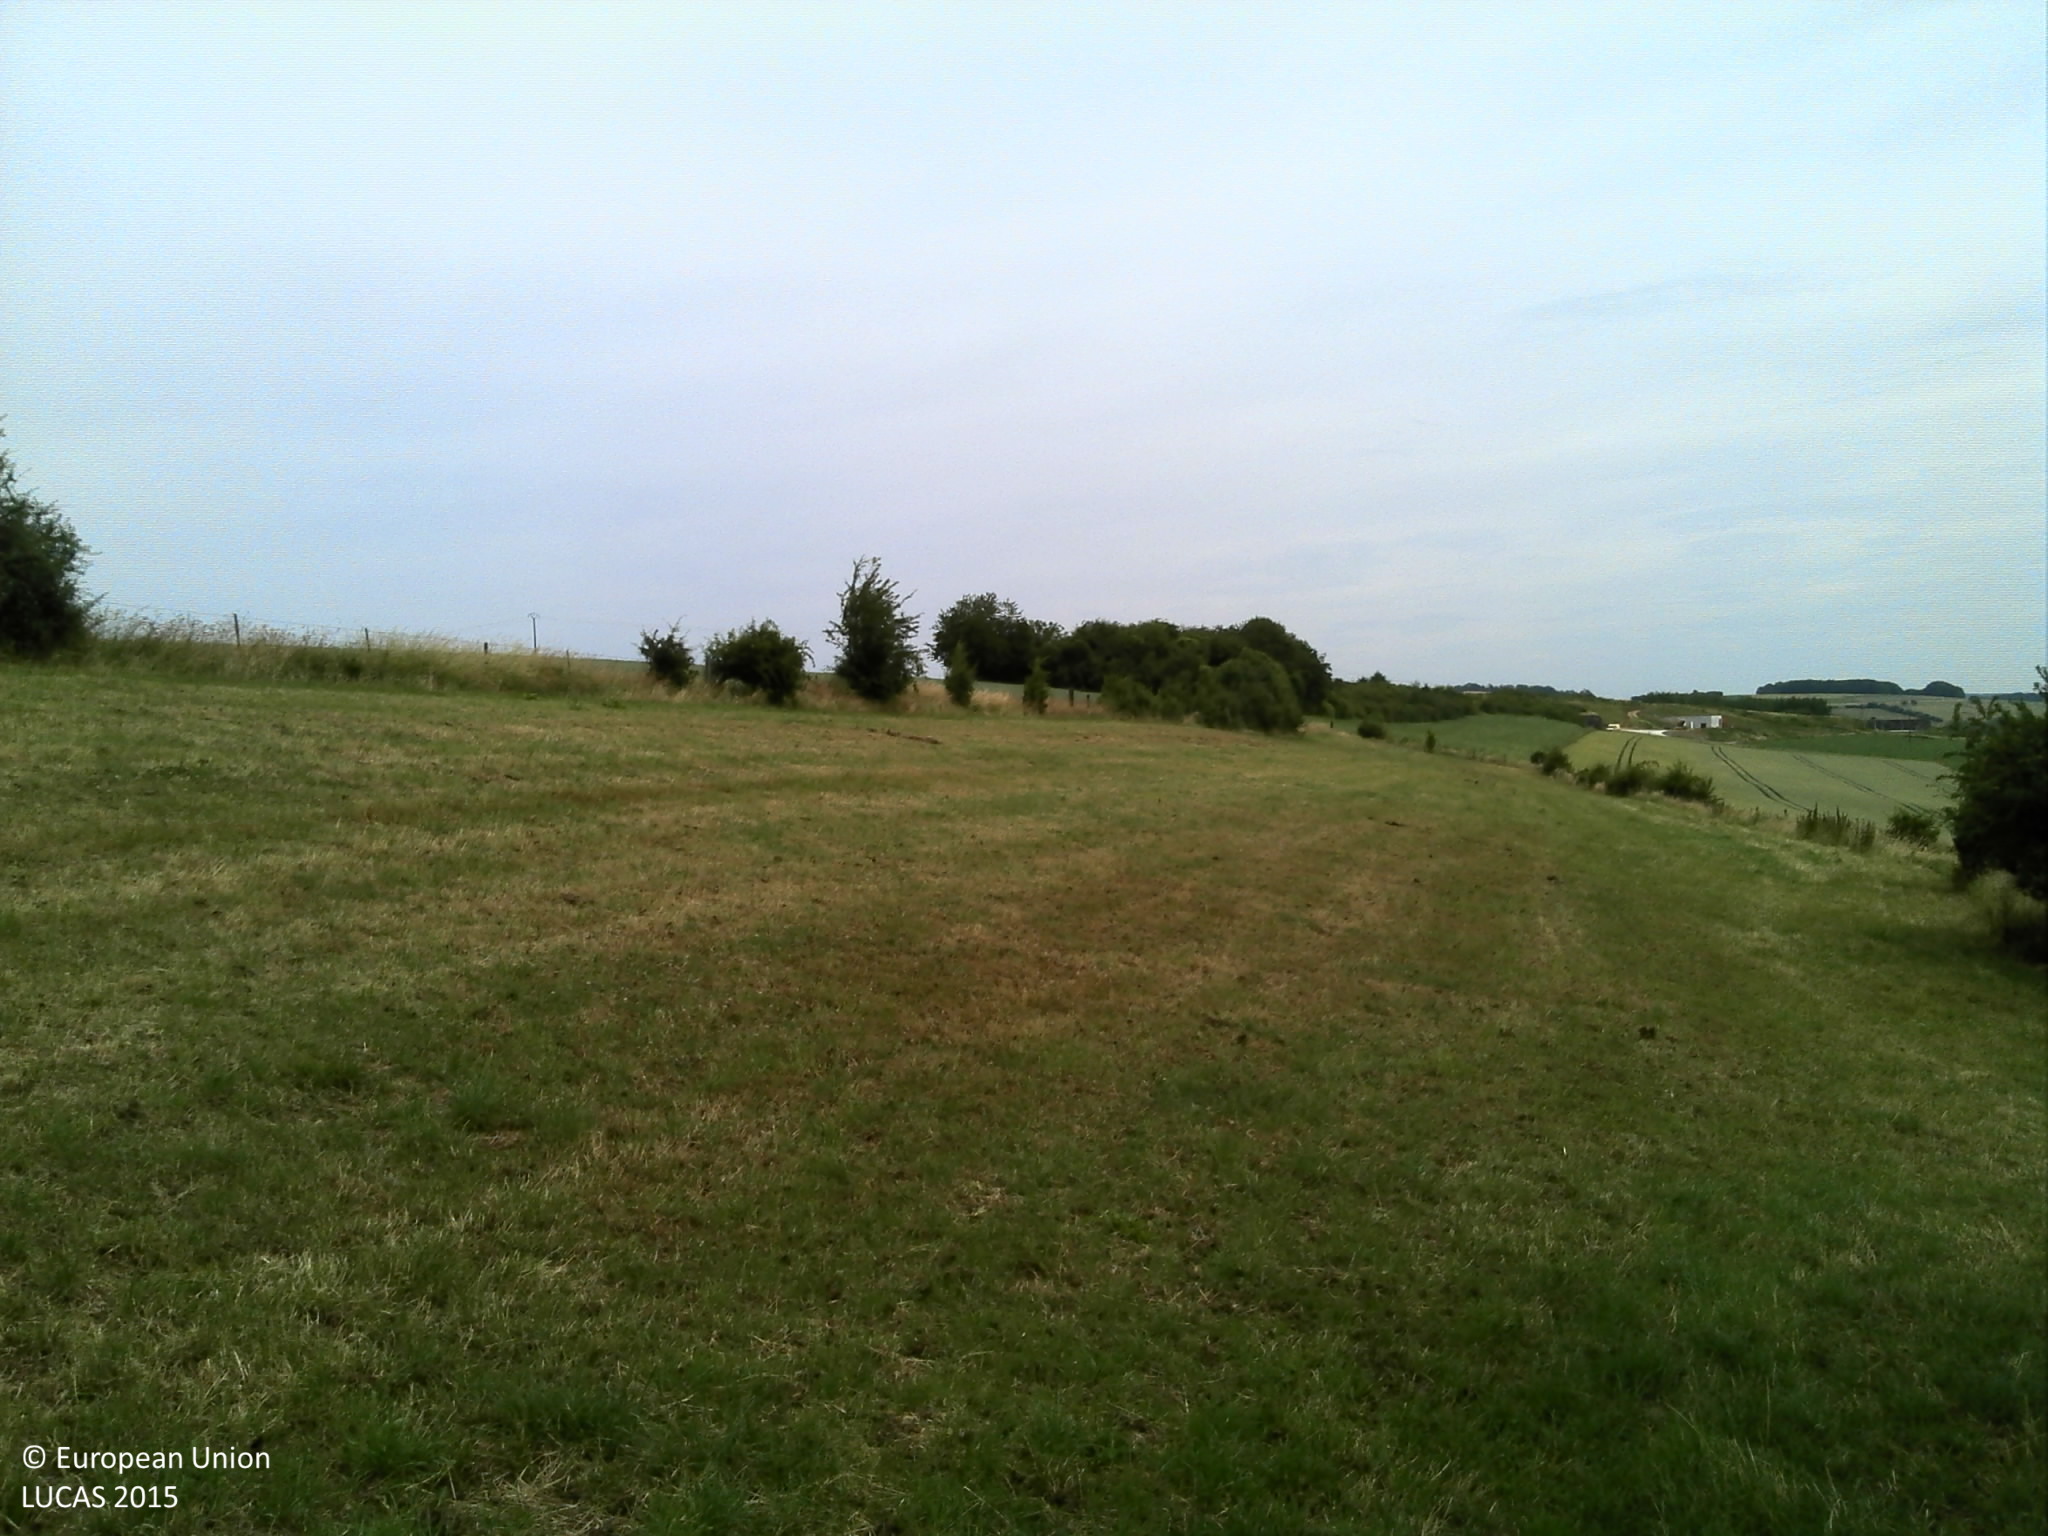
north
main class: Grassland
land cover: Grassland without tree/shrub cover
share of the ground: > 75 %
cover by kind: herbaceous plants 100 %
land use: Agriculture (excluding fallow land and kitchen gardens)
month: June
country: FR
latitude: 49.5799
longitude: 5.2264
